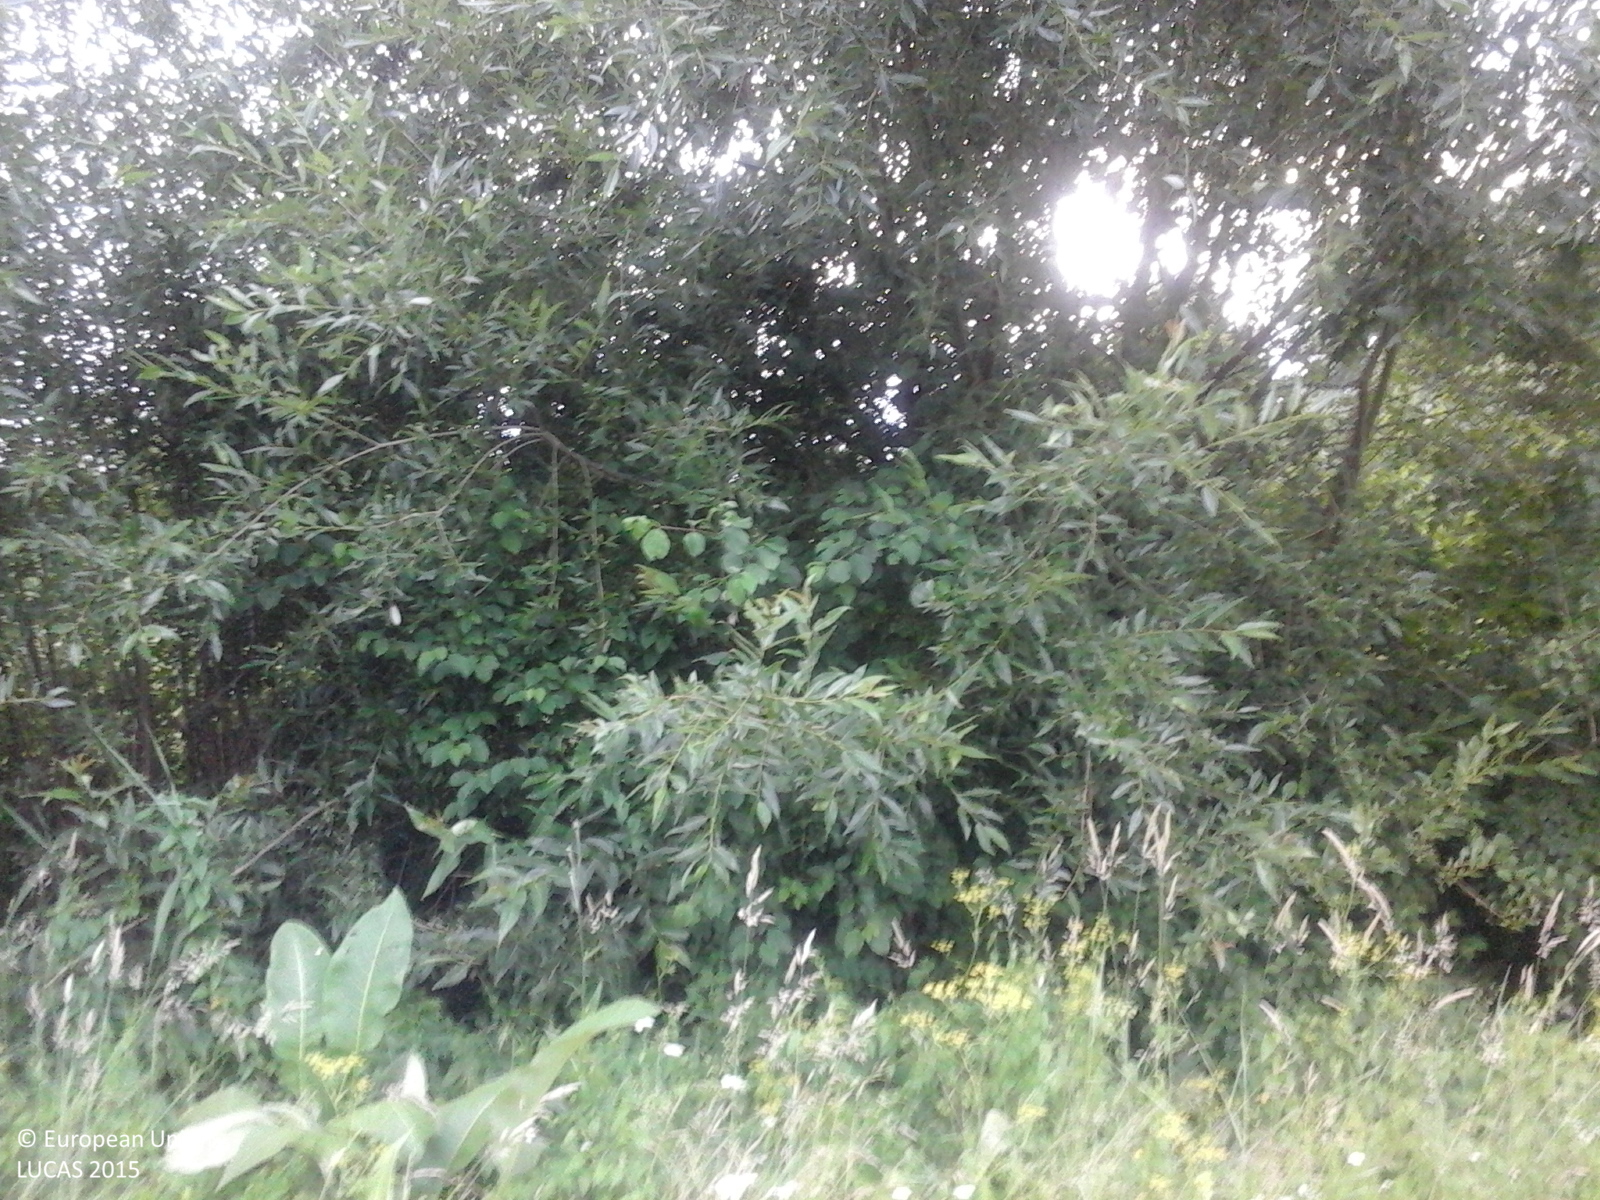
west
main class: Grassland
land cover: Grassland with sparse tree/shrub cover
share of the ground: > 75 %
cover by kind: herbaceous plants 90 %, broadleaved forest trees 5 %, shrubs 5 %
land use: Agriculture (excluding fallow land and kitchen gardens)
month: July
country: RO
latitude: 45.1924
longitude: 24.7582
